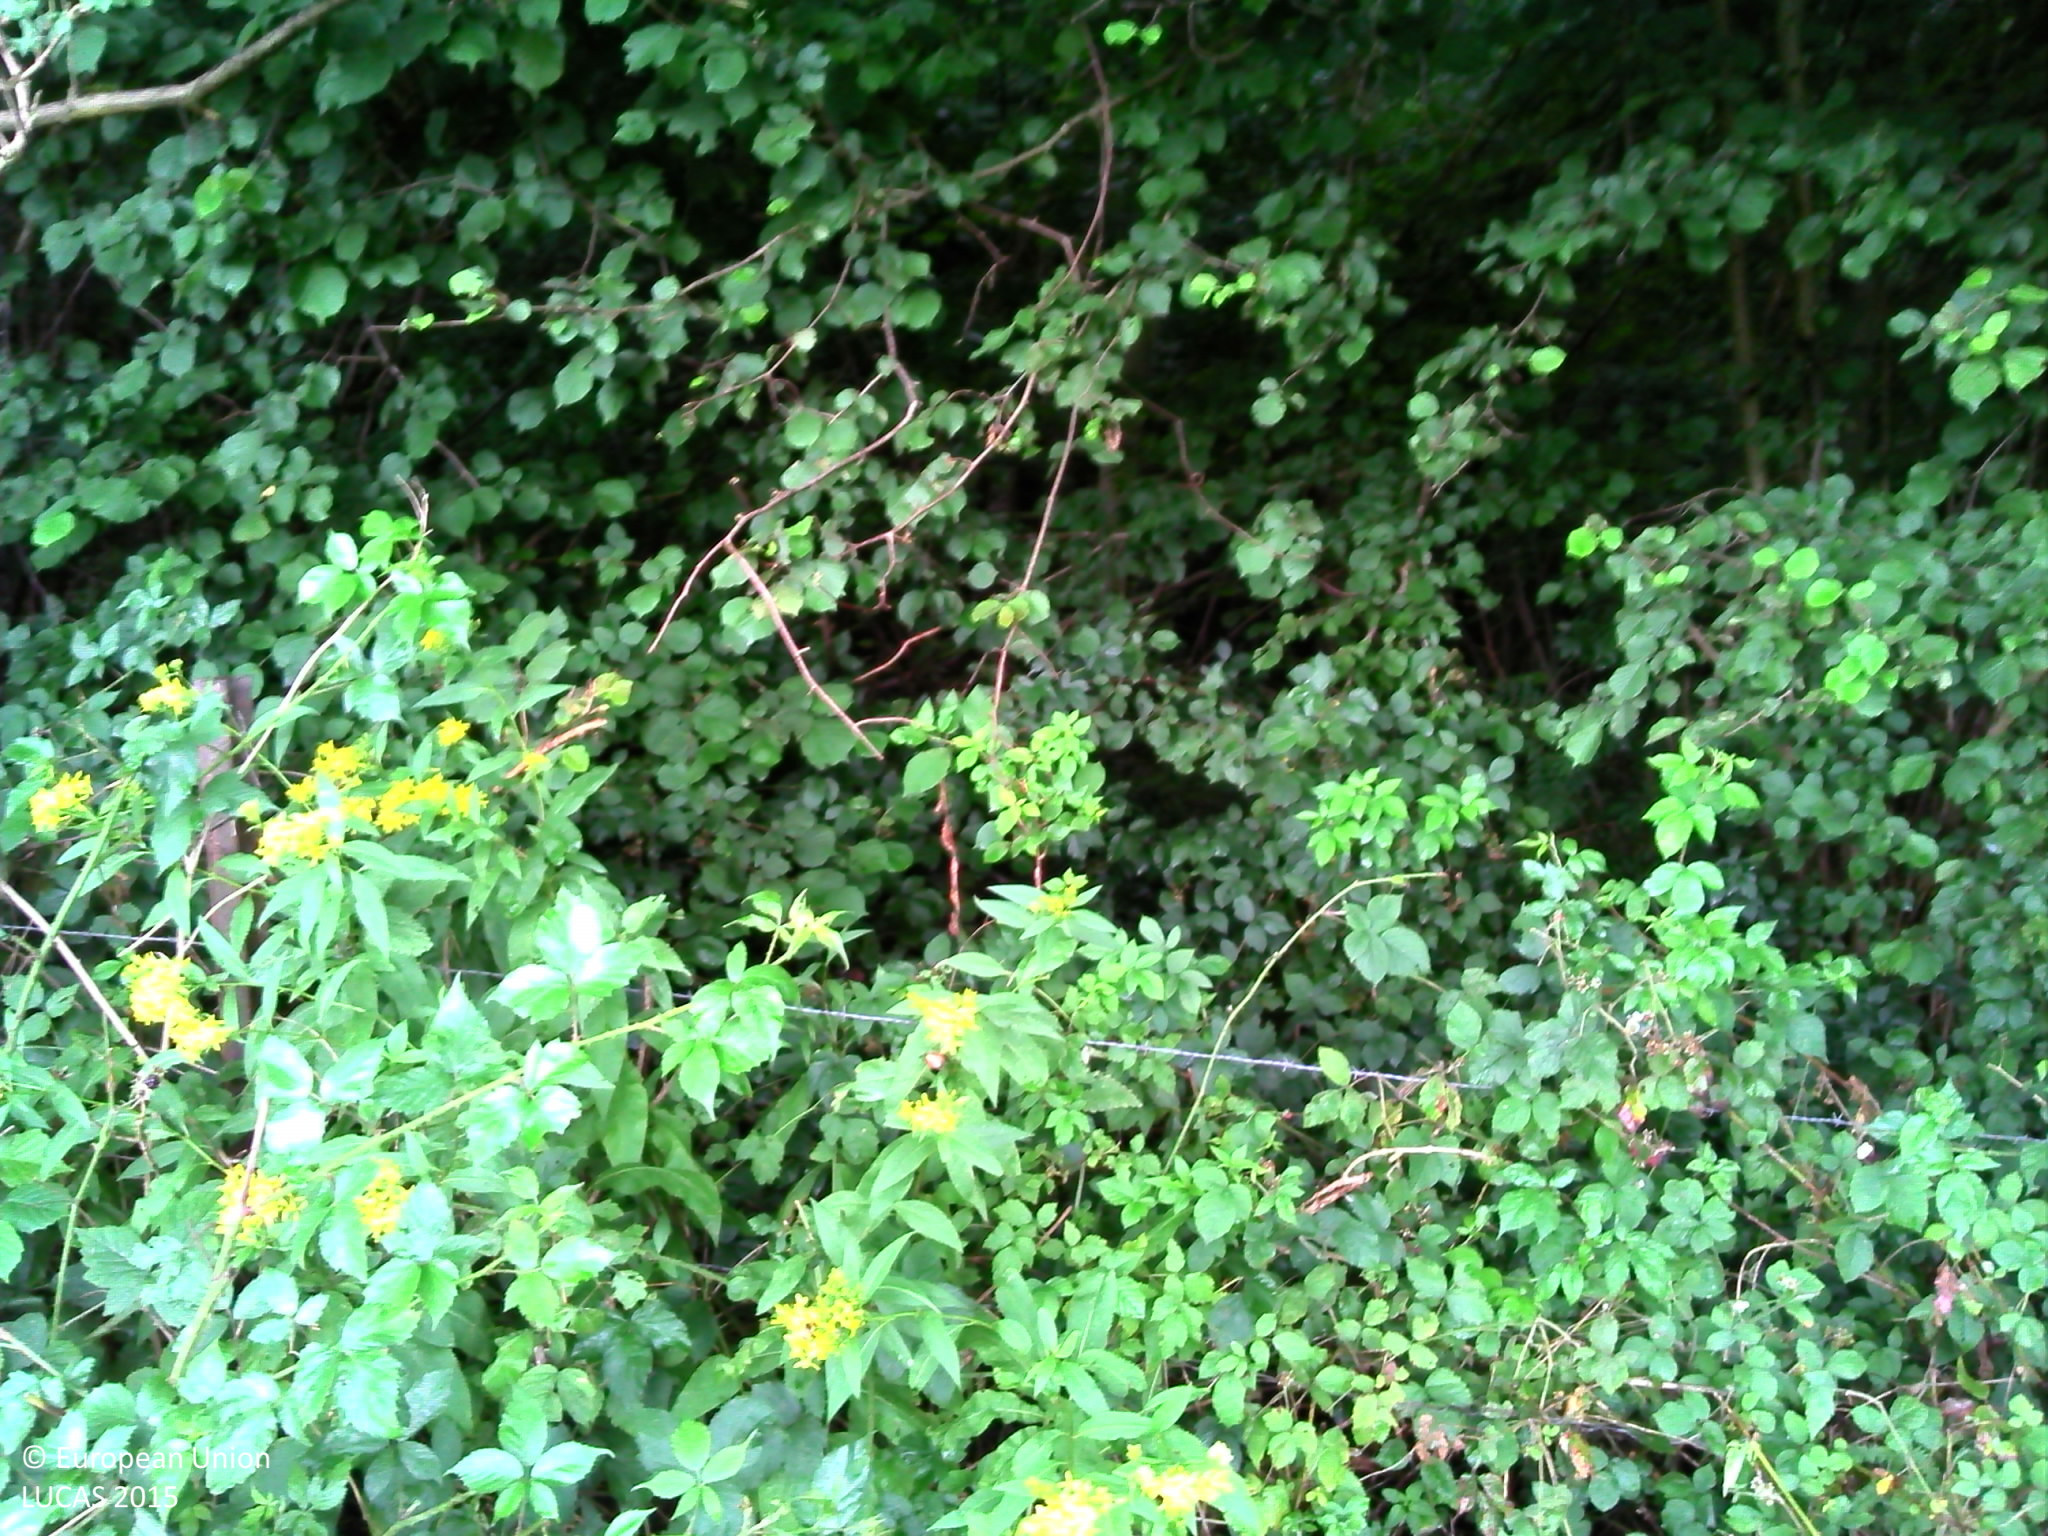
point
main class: Woodland
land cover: Broadleaved woodland
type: mesophytic deciduous forest
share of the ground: > 75 %
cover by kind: broadleaved forest trees 85 %, lichens and mosses 10 %, herbaceous plants 5 %
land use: Forestry
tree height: > 5 m
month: August
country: FR
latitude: 50.2115
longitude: 4.0952
